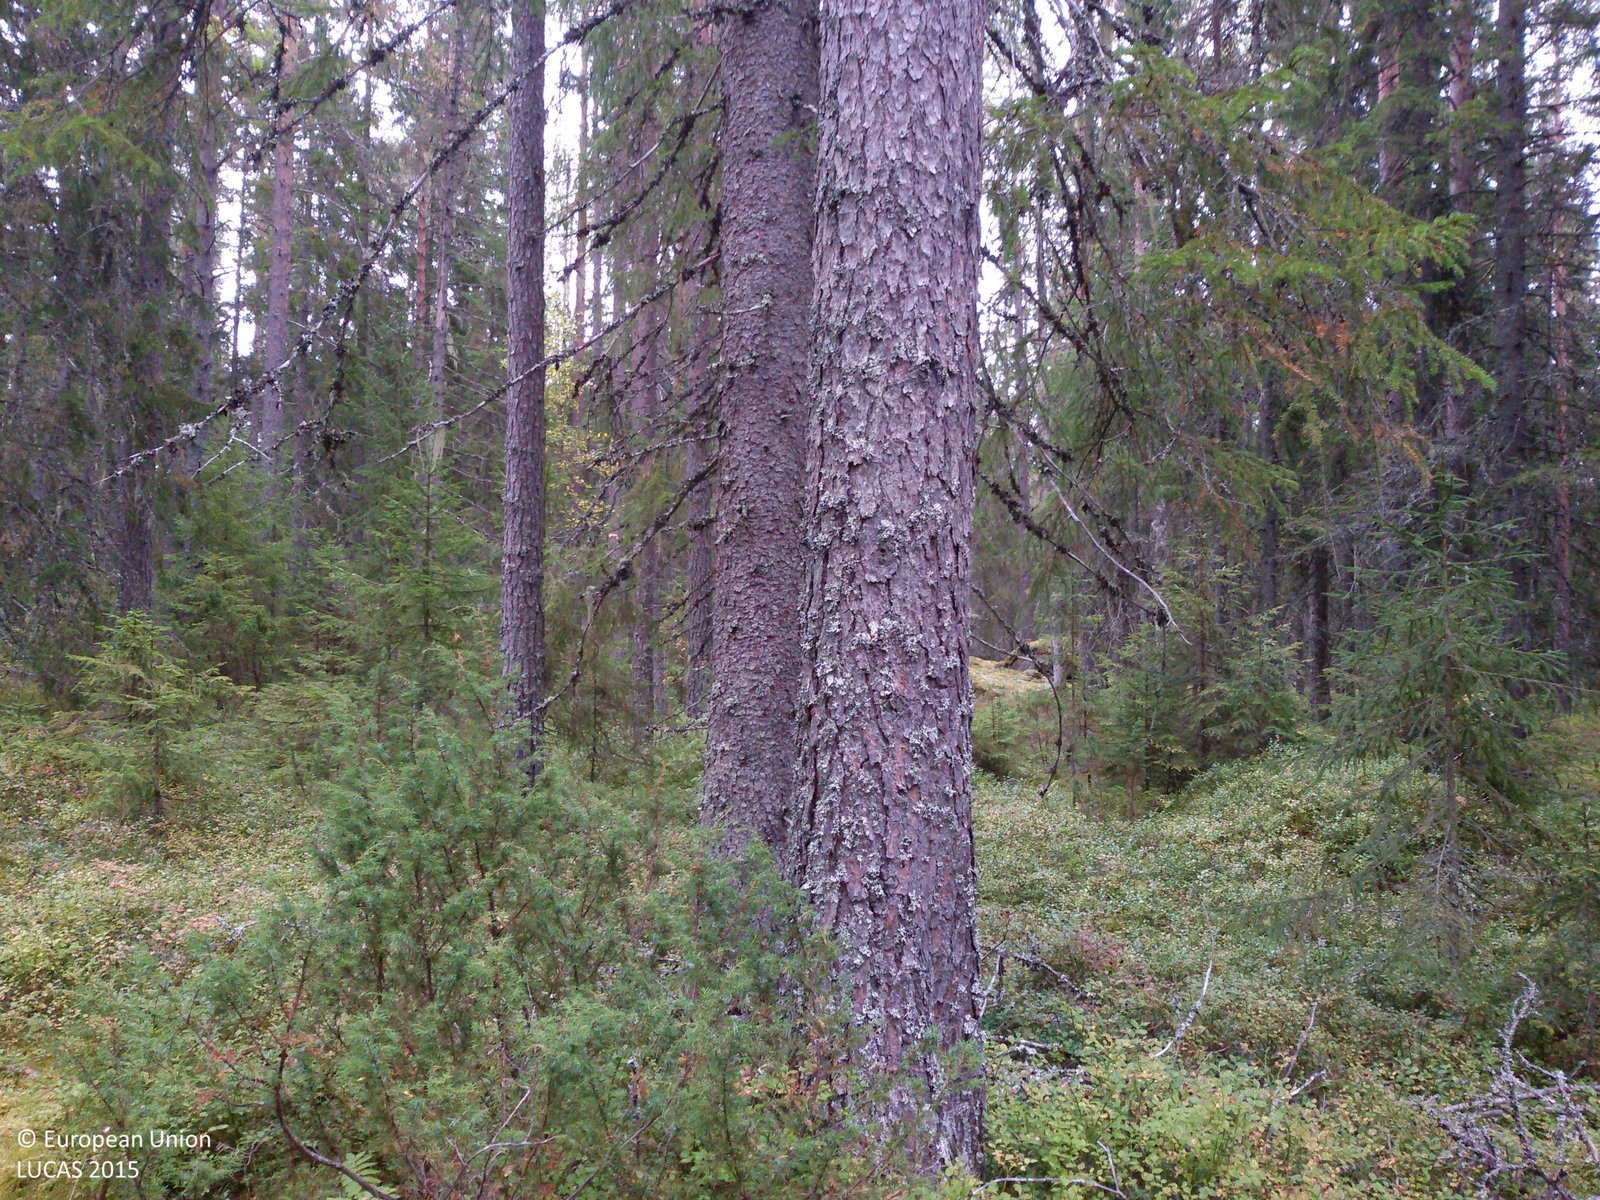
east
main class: Woodland
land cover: Spruce dominated mixed woodland
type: boreal forest
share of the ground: 50 - 75 %
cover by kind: coniferous forest trees 45 %, broadleaved forest trees 25 %, herbaceous plants 15 %, lichens and mosses 15 %
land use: Forestry
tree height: > 5 m
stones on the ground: 10 - 25 %
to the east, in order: Spruce dominated mixed woodland; Rivers and streams; Spruce dominated mixed woodland; Spruce dominated coniferous woodland; Pine dominated coniferous woodland
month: September
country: SE
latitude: 61.0518
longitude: 14.3392
